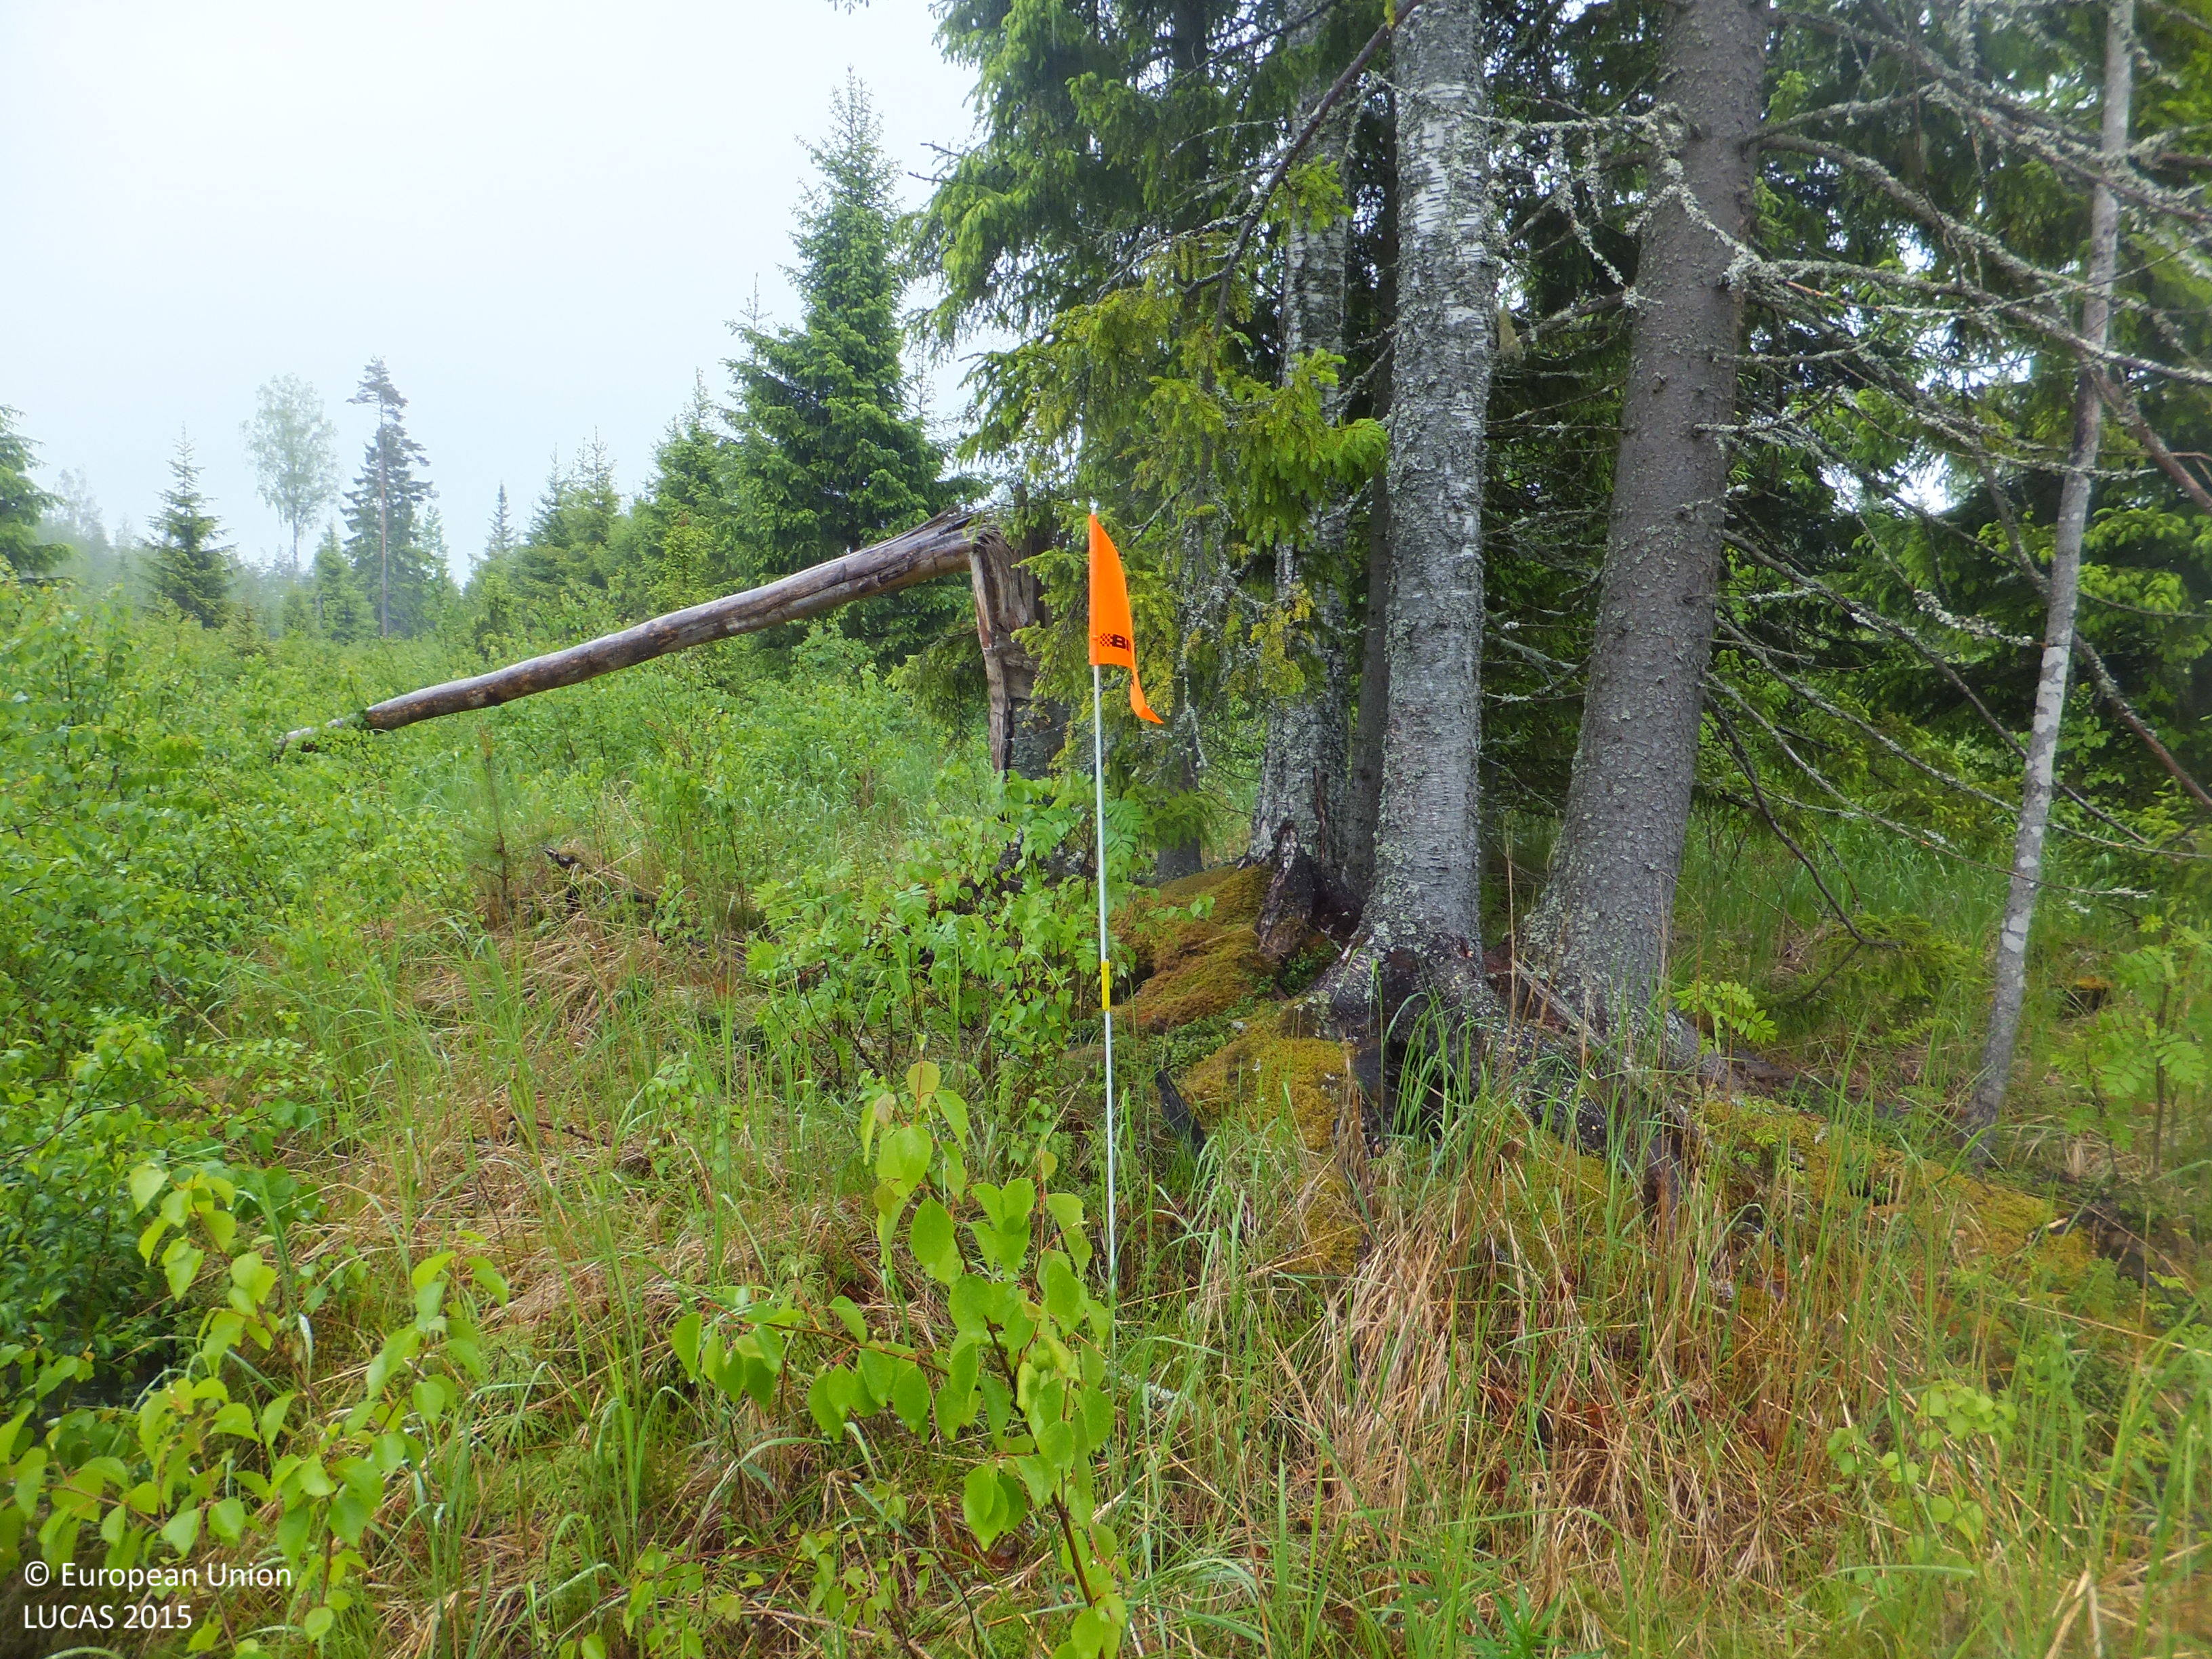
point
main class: Woodland
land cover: Spruce dominated mixed woodland
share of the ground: 50 - 75 %
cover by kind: broadleaved forest trees 40 %, herbaceous plants 30 %, coniferous forest trees 20 %, lichens and mosses 10 %
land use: Forestry
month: June
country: FI
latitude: 63.7372
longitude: 24.9752
